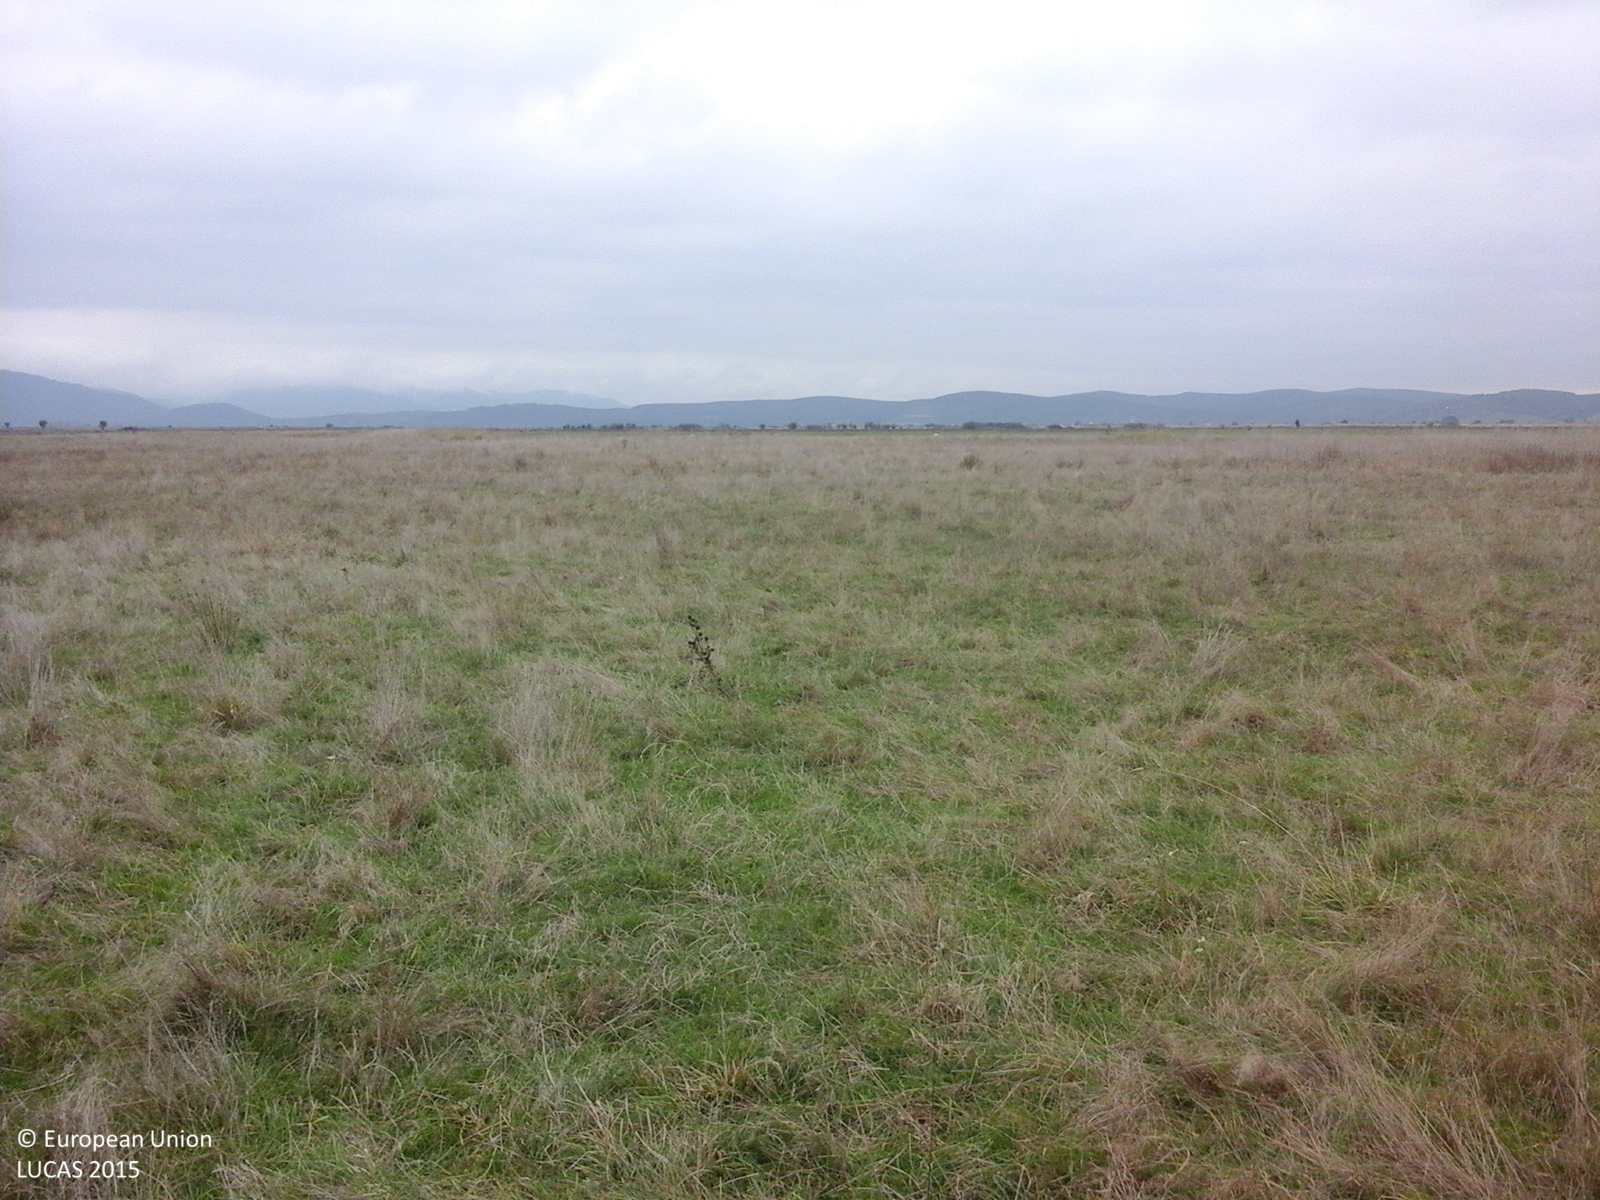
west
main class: Grassland
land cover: Grassland without tree/shrub cover
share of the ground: > 75 %
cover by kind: herbaceous plants 100 %
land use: Agriculture (excluding fallow land and kitchen gardens)
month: October
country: RO
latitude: 45.7655
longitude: 24.0496
